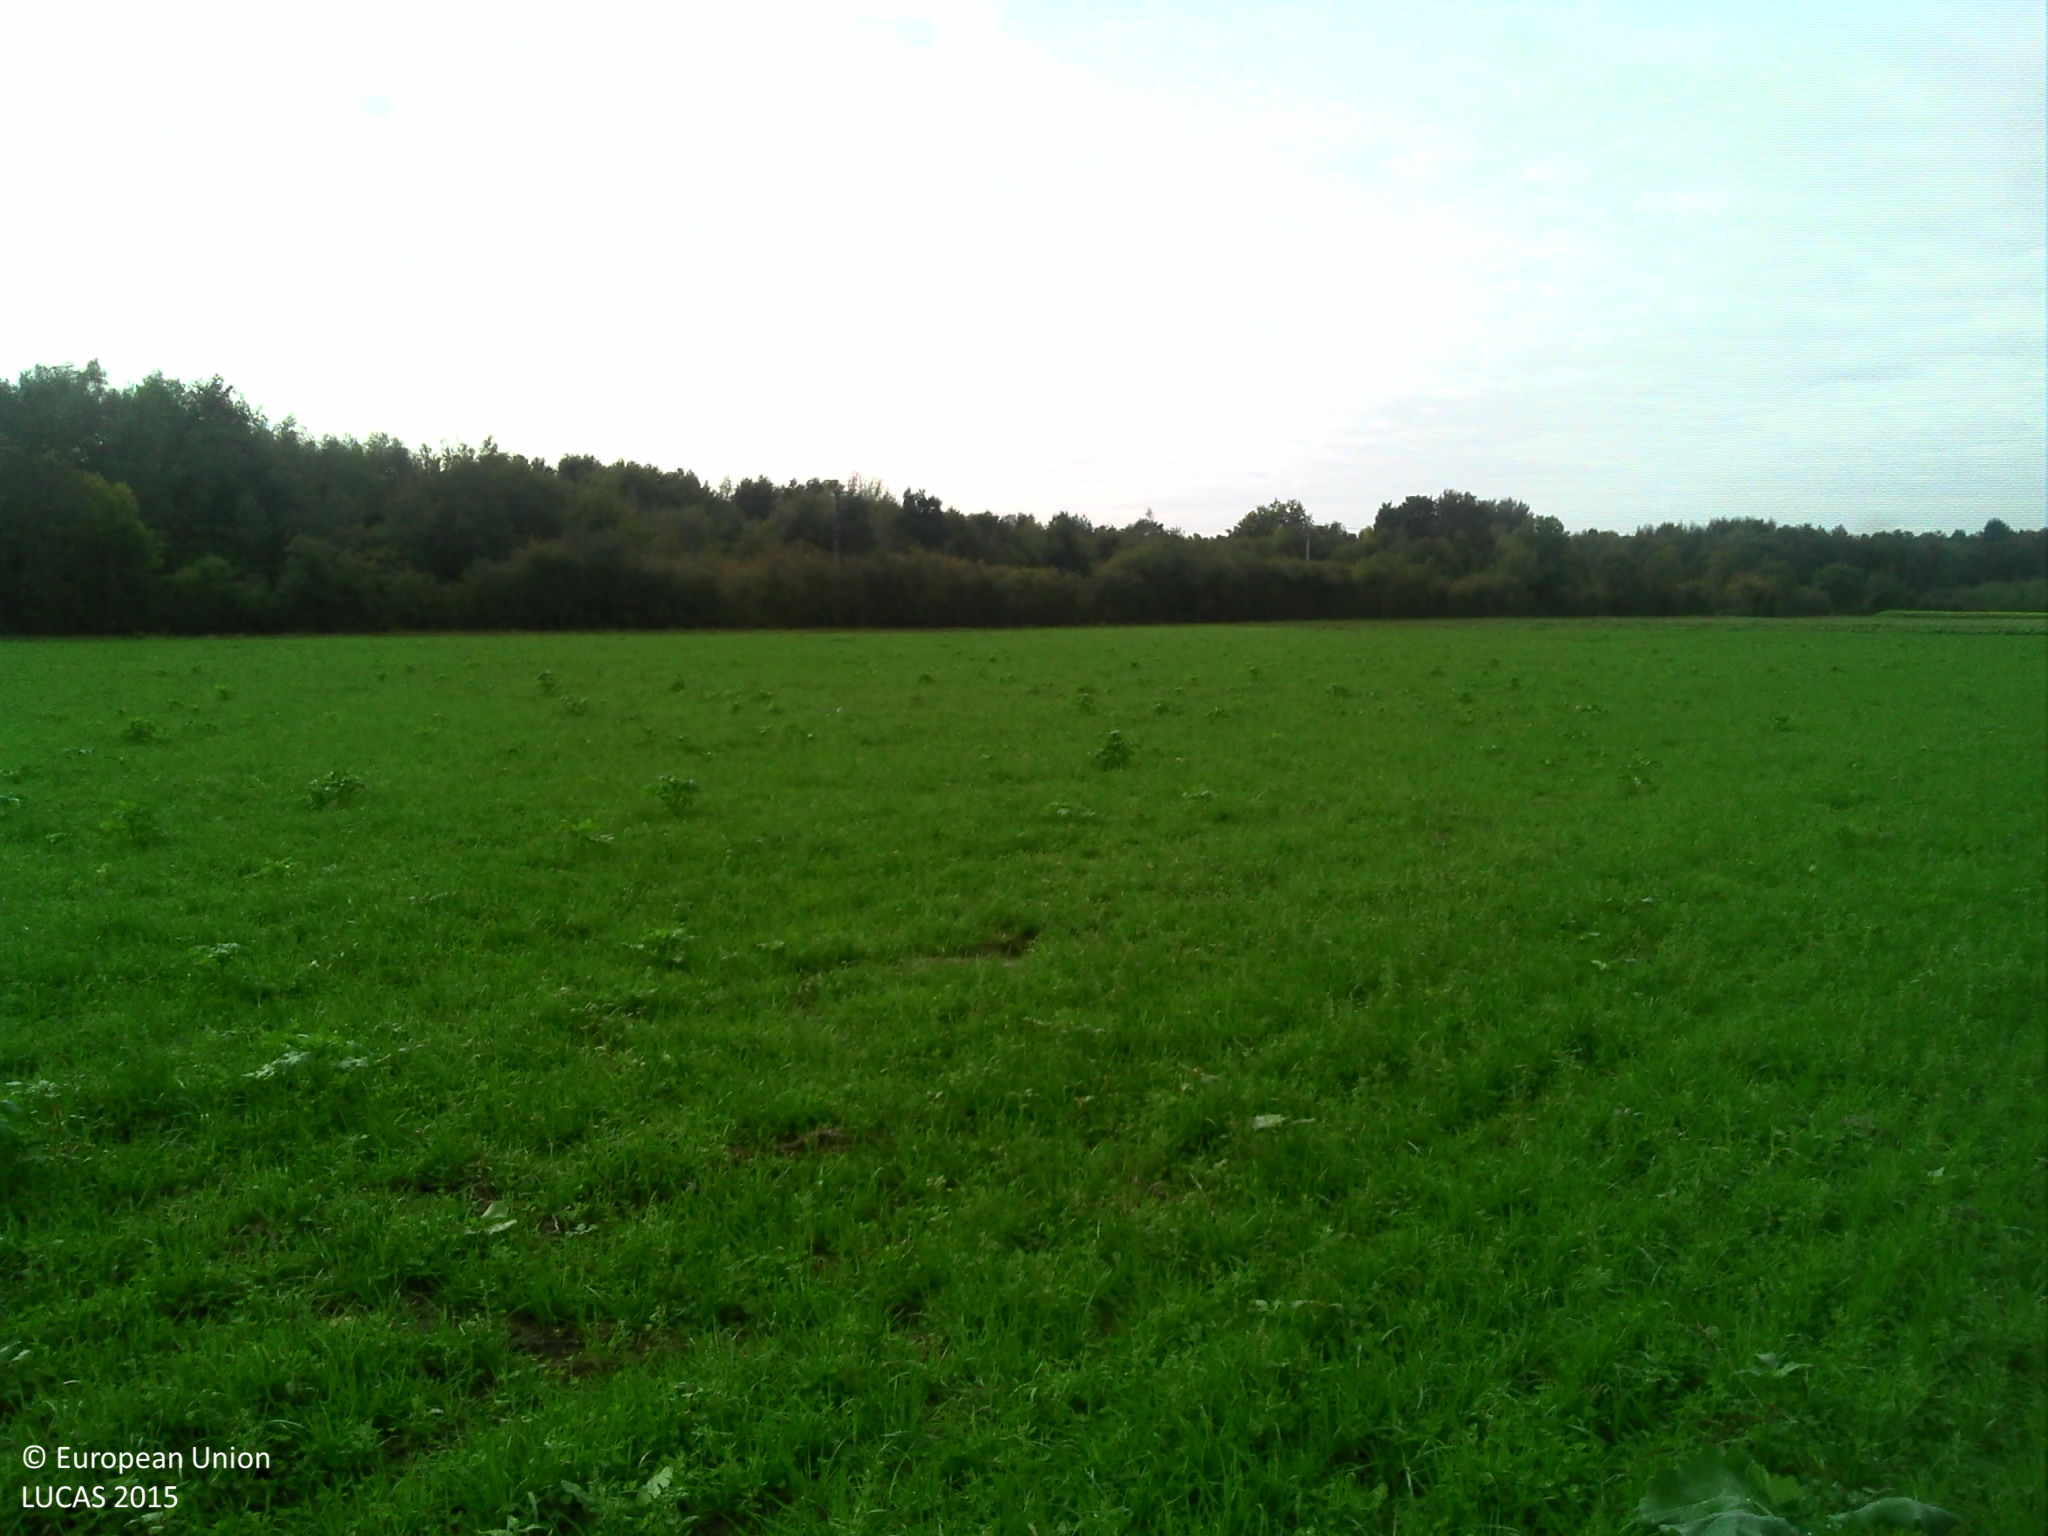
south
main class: Cropland
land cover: Temporary grasslands
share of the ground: > 75 %
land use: Agriculture (excluding fallow land and kitchen gardens)
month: October
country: FR
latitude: 47.5607
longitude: 2.1084
